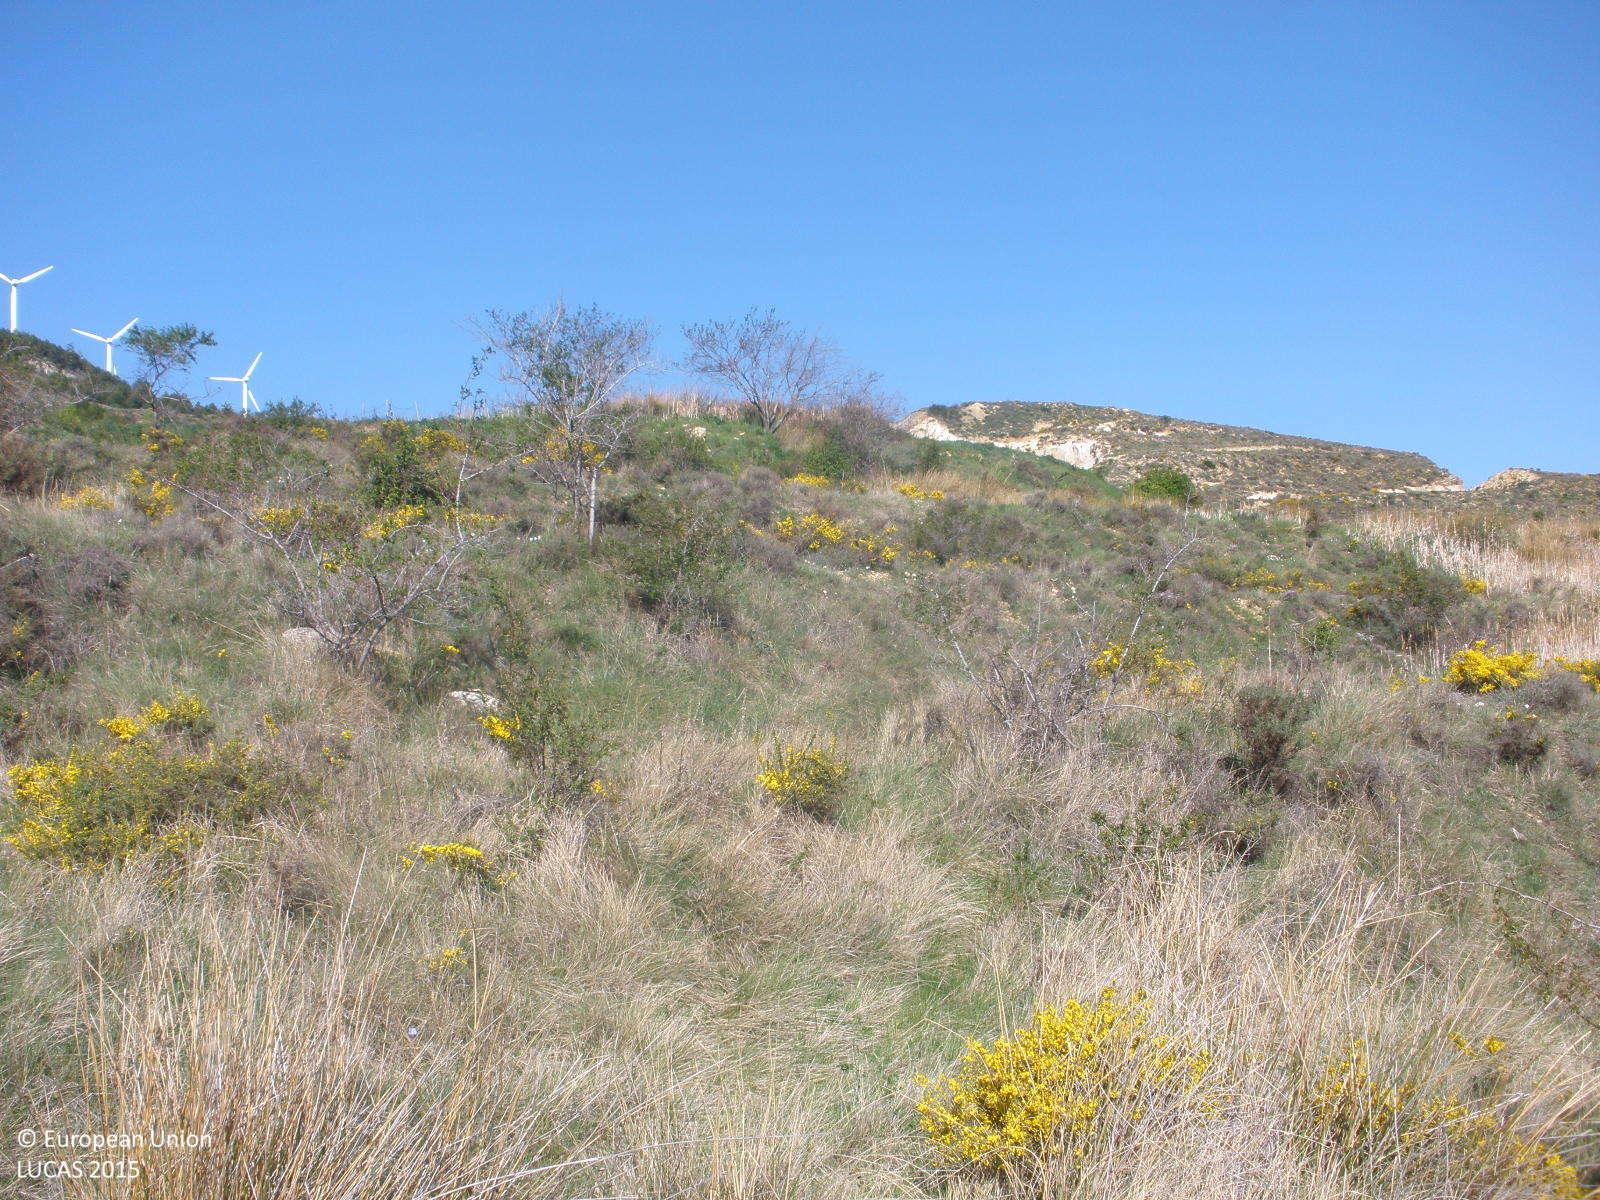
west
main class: Shrubland
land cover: Shrubland without tree cover
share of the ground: > 75 %
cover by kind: herbaceous plants 60 %, shrubs 40 %
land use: Semi-natural and natural areas not in use
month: May
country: ES
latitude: 40.7781
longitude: -0.8311
